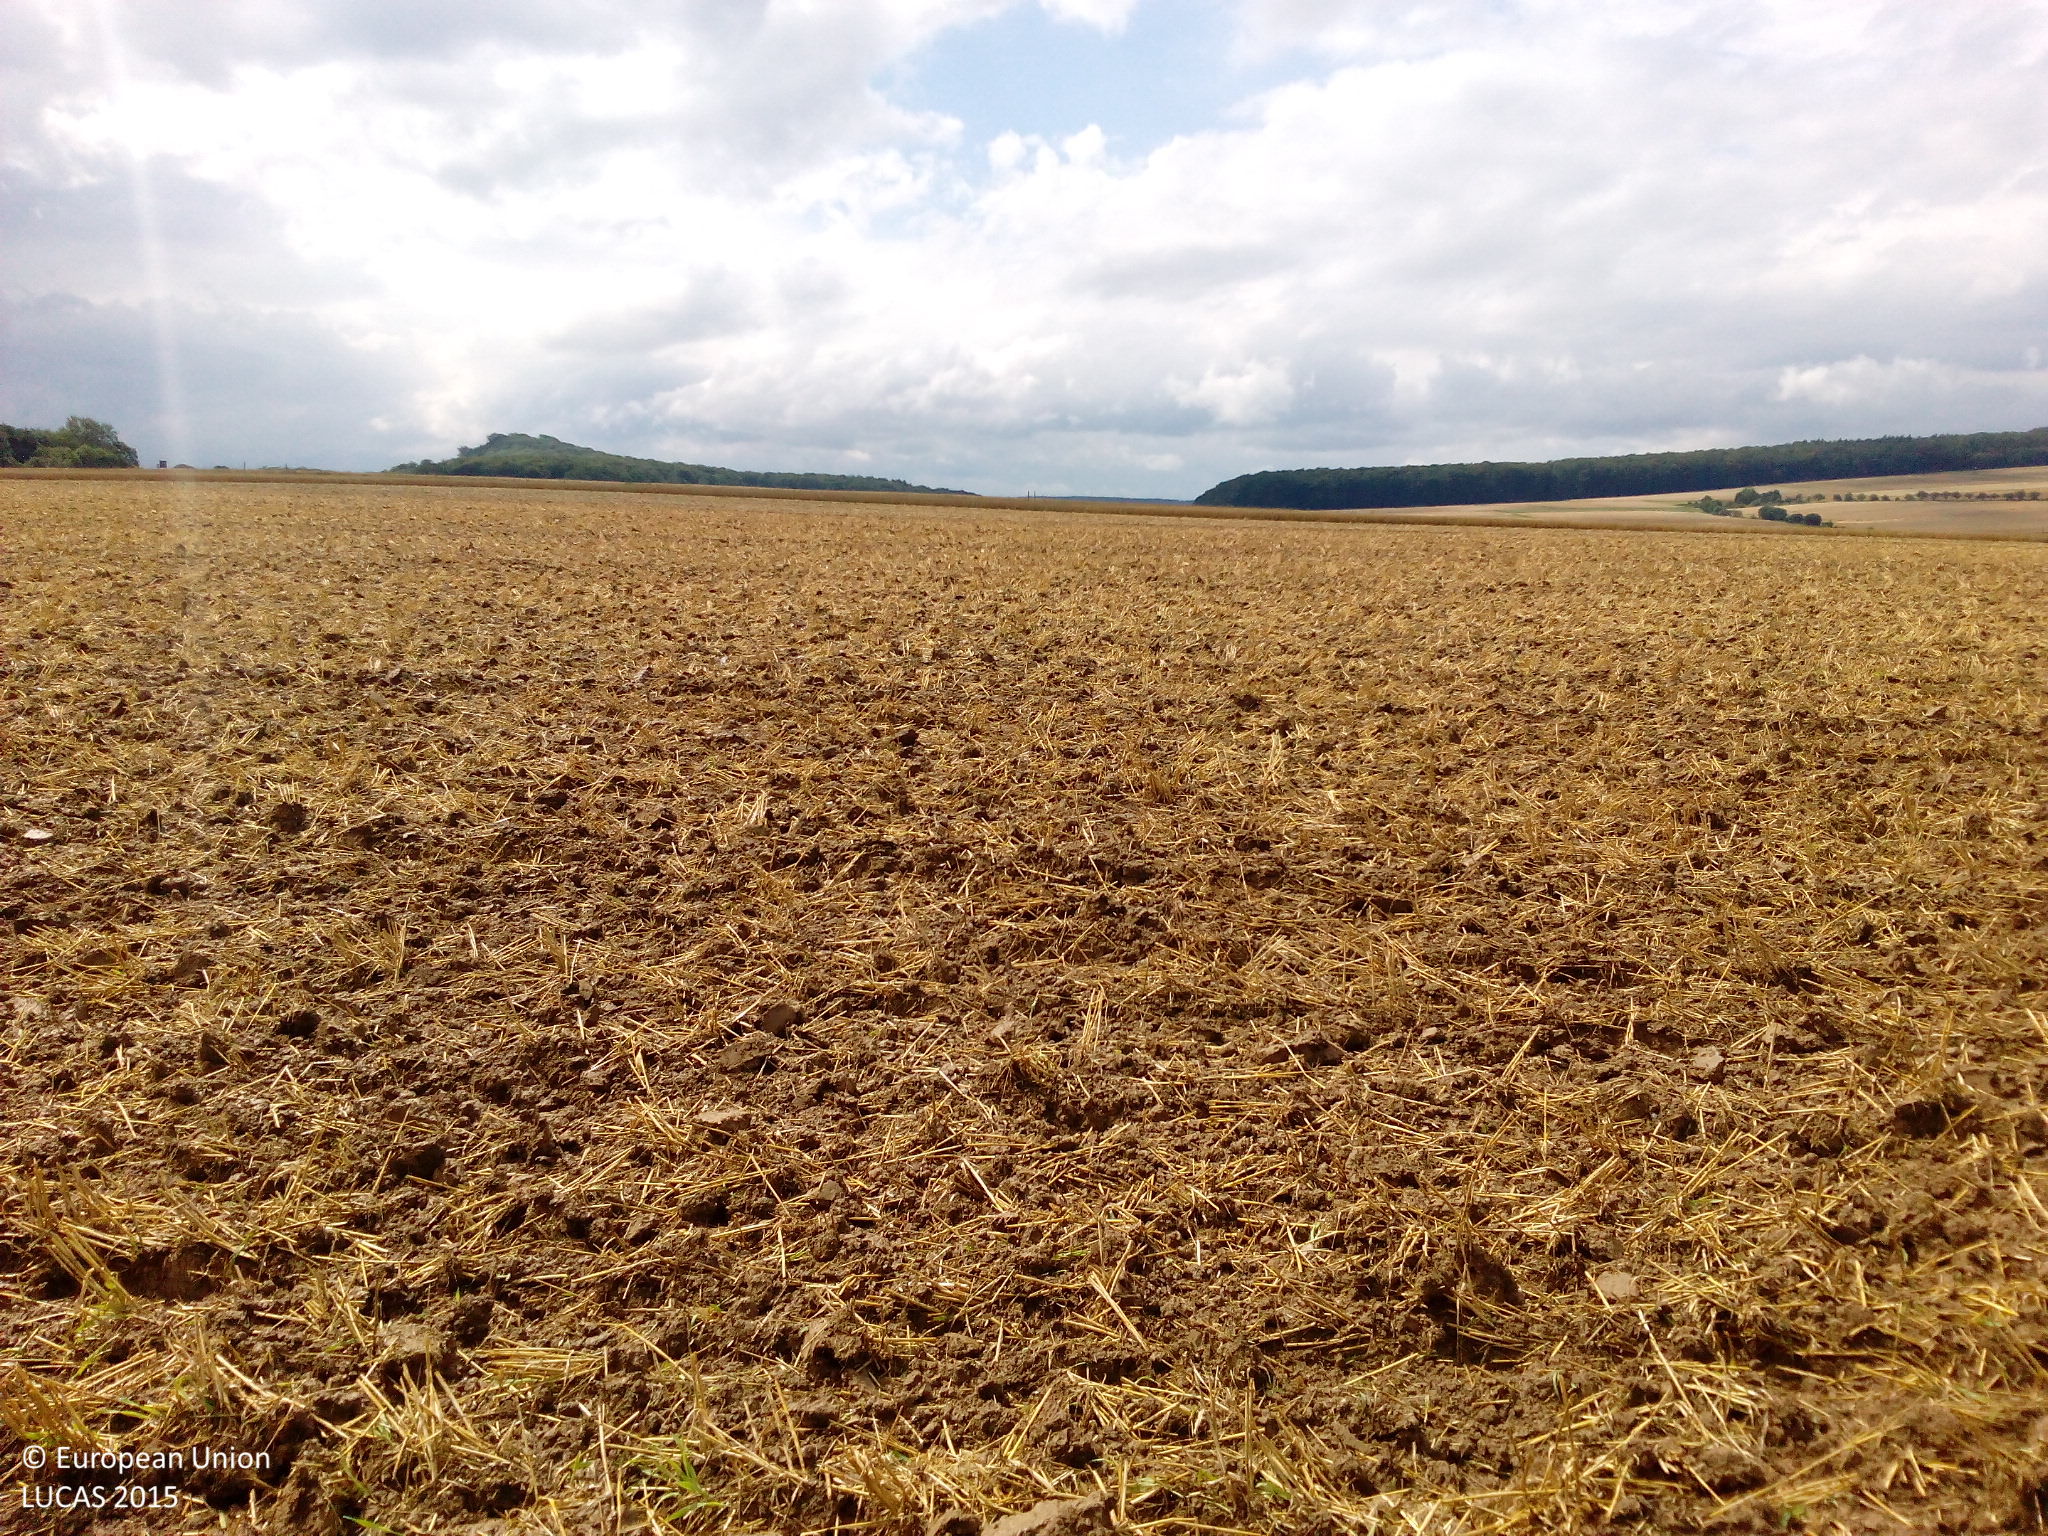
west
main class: Cropland
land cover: Barley
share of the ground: < 10 %
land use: Agriculture (excluding fallow land and kitchen gardens)
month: July
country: DE
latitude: 51.4769
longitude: 9.3523
